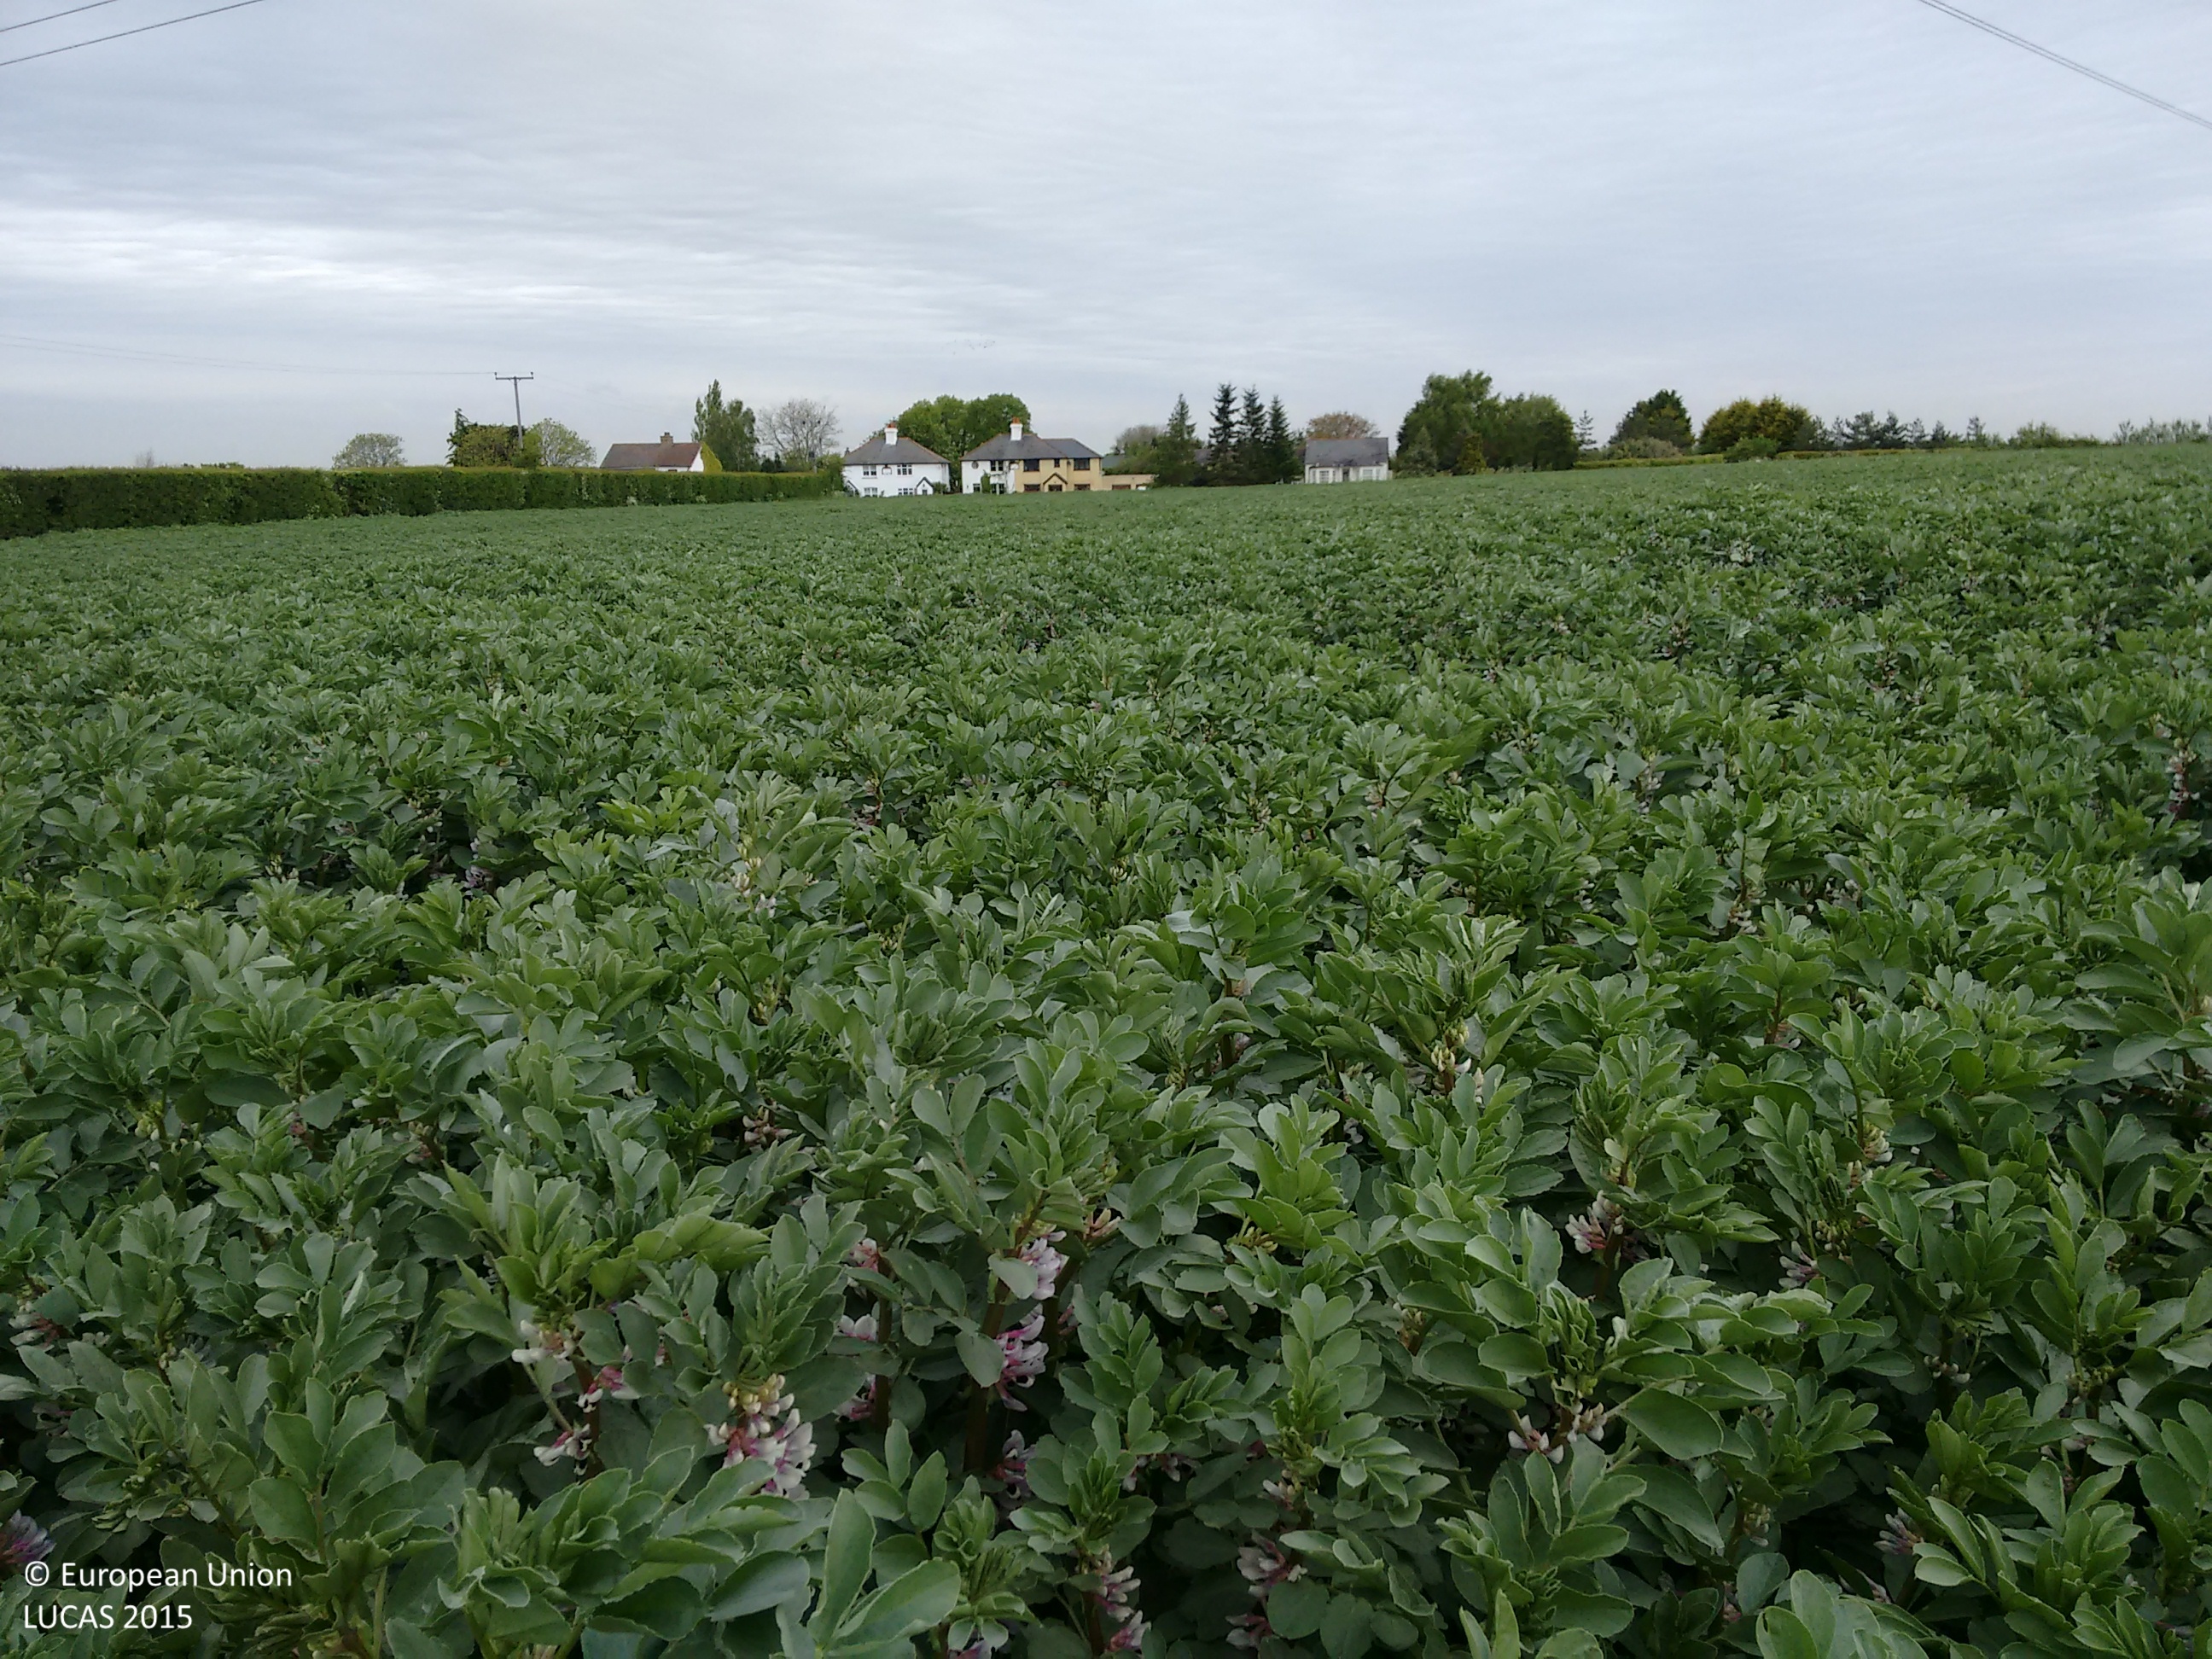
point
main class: Cropland
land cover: Dry pulses
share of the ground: > 75 %
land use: Agriculture (excluding fallow land and kitchen gardens)
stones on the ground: 10 - 25 %
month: May
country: GB
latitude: 51.3972
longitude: 0.2680
